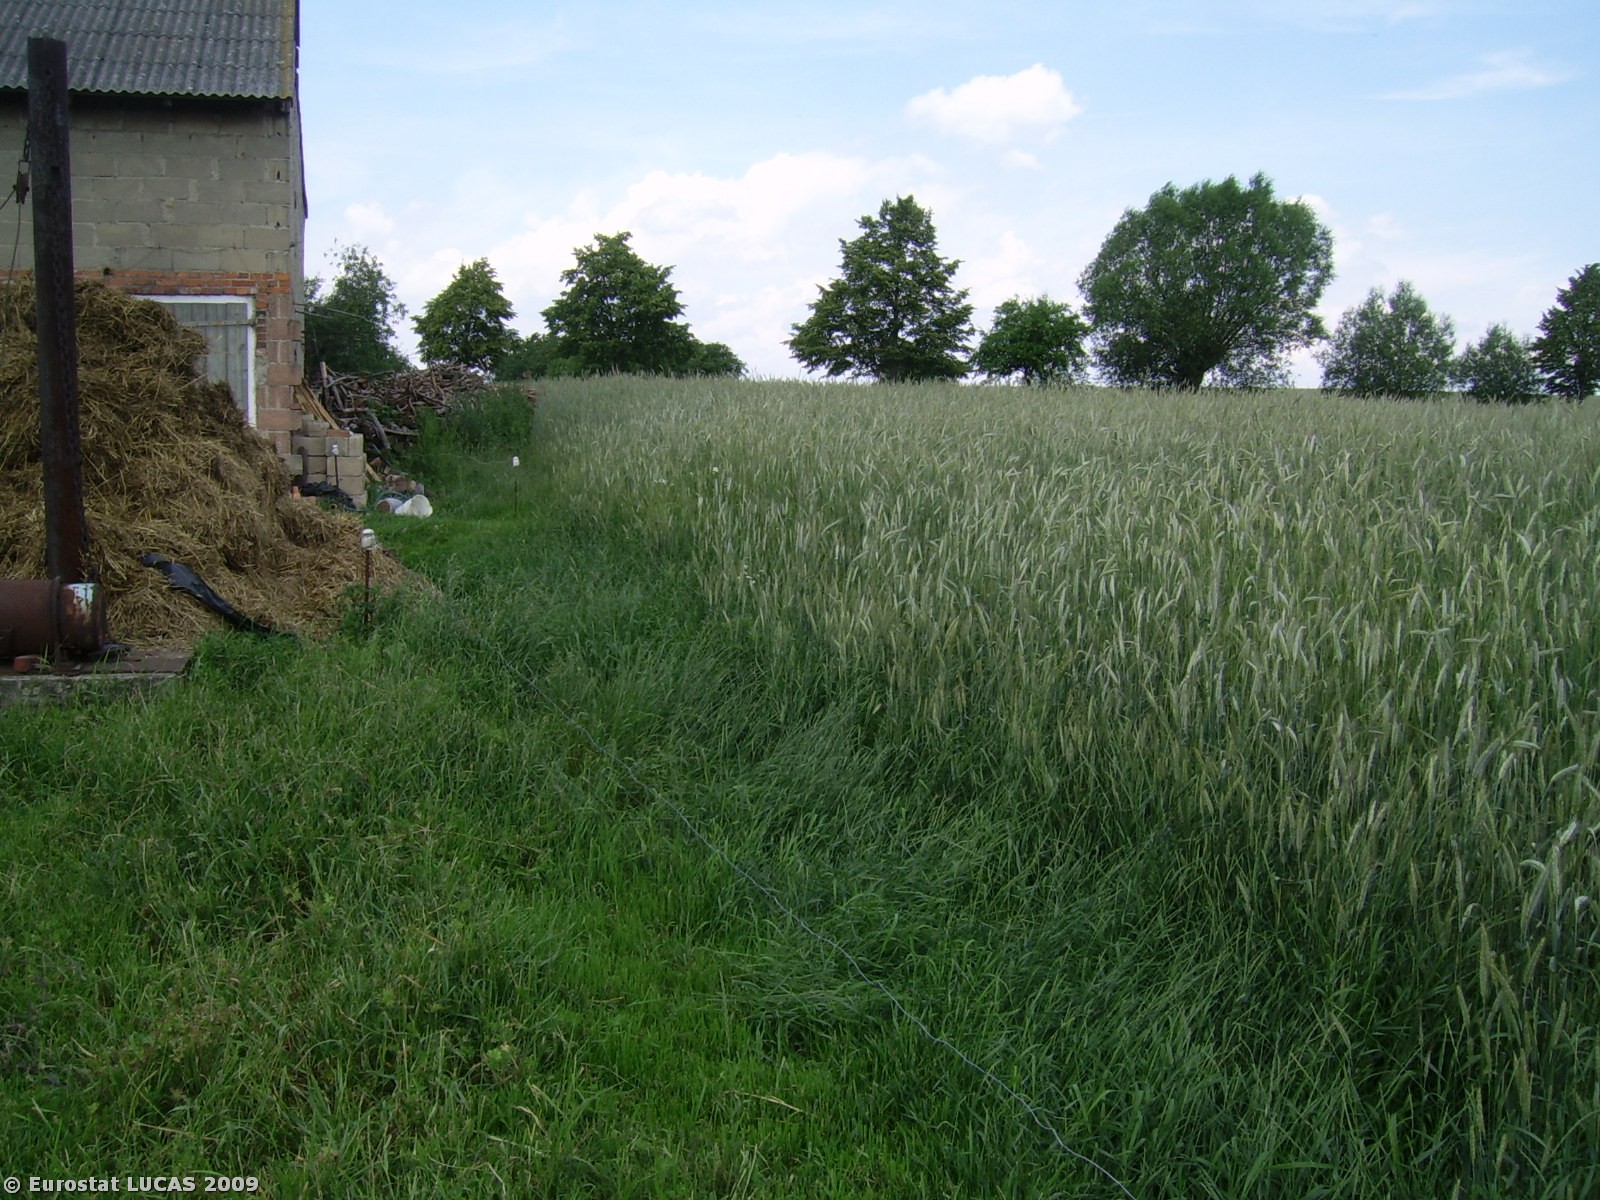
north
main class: Grassland
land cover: Grassland without tree/shrub cover
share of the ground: > 75 %
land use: Agriculture (excluding fallow land and kitchen gardens)
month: June
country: PL
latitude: 51.5300
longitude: 17.9873
